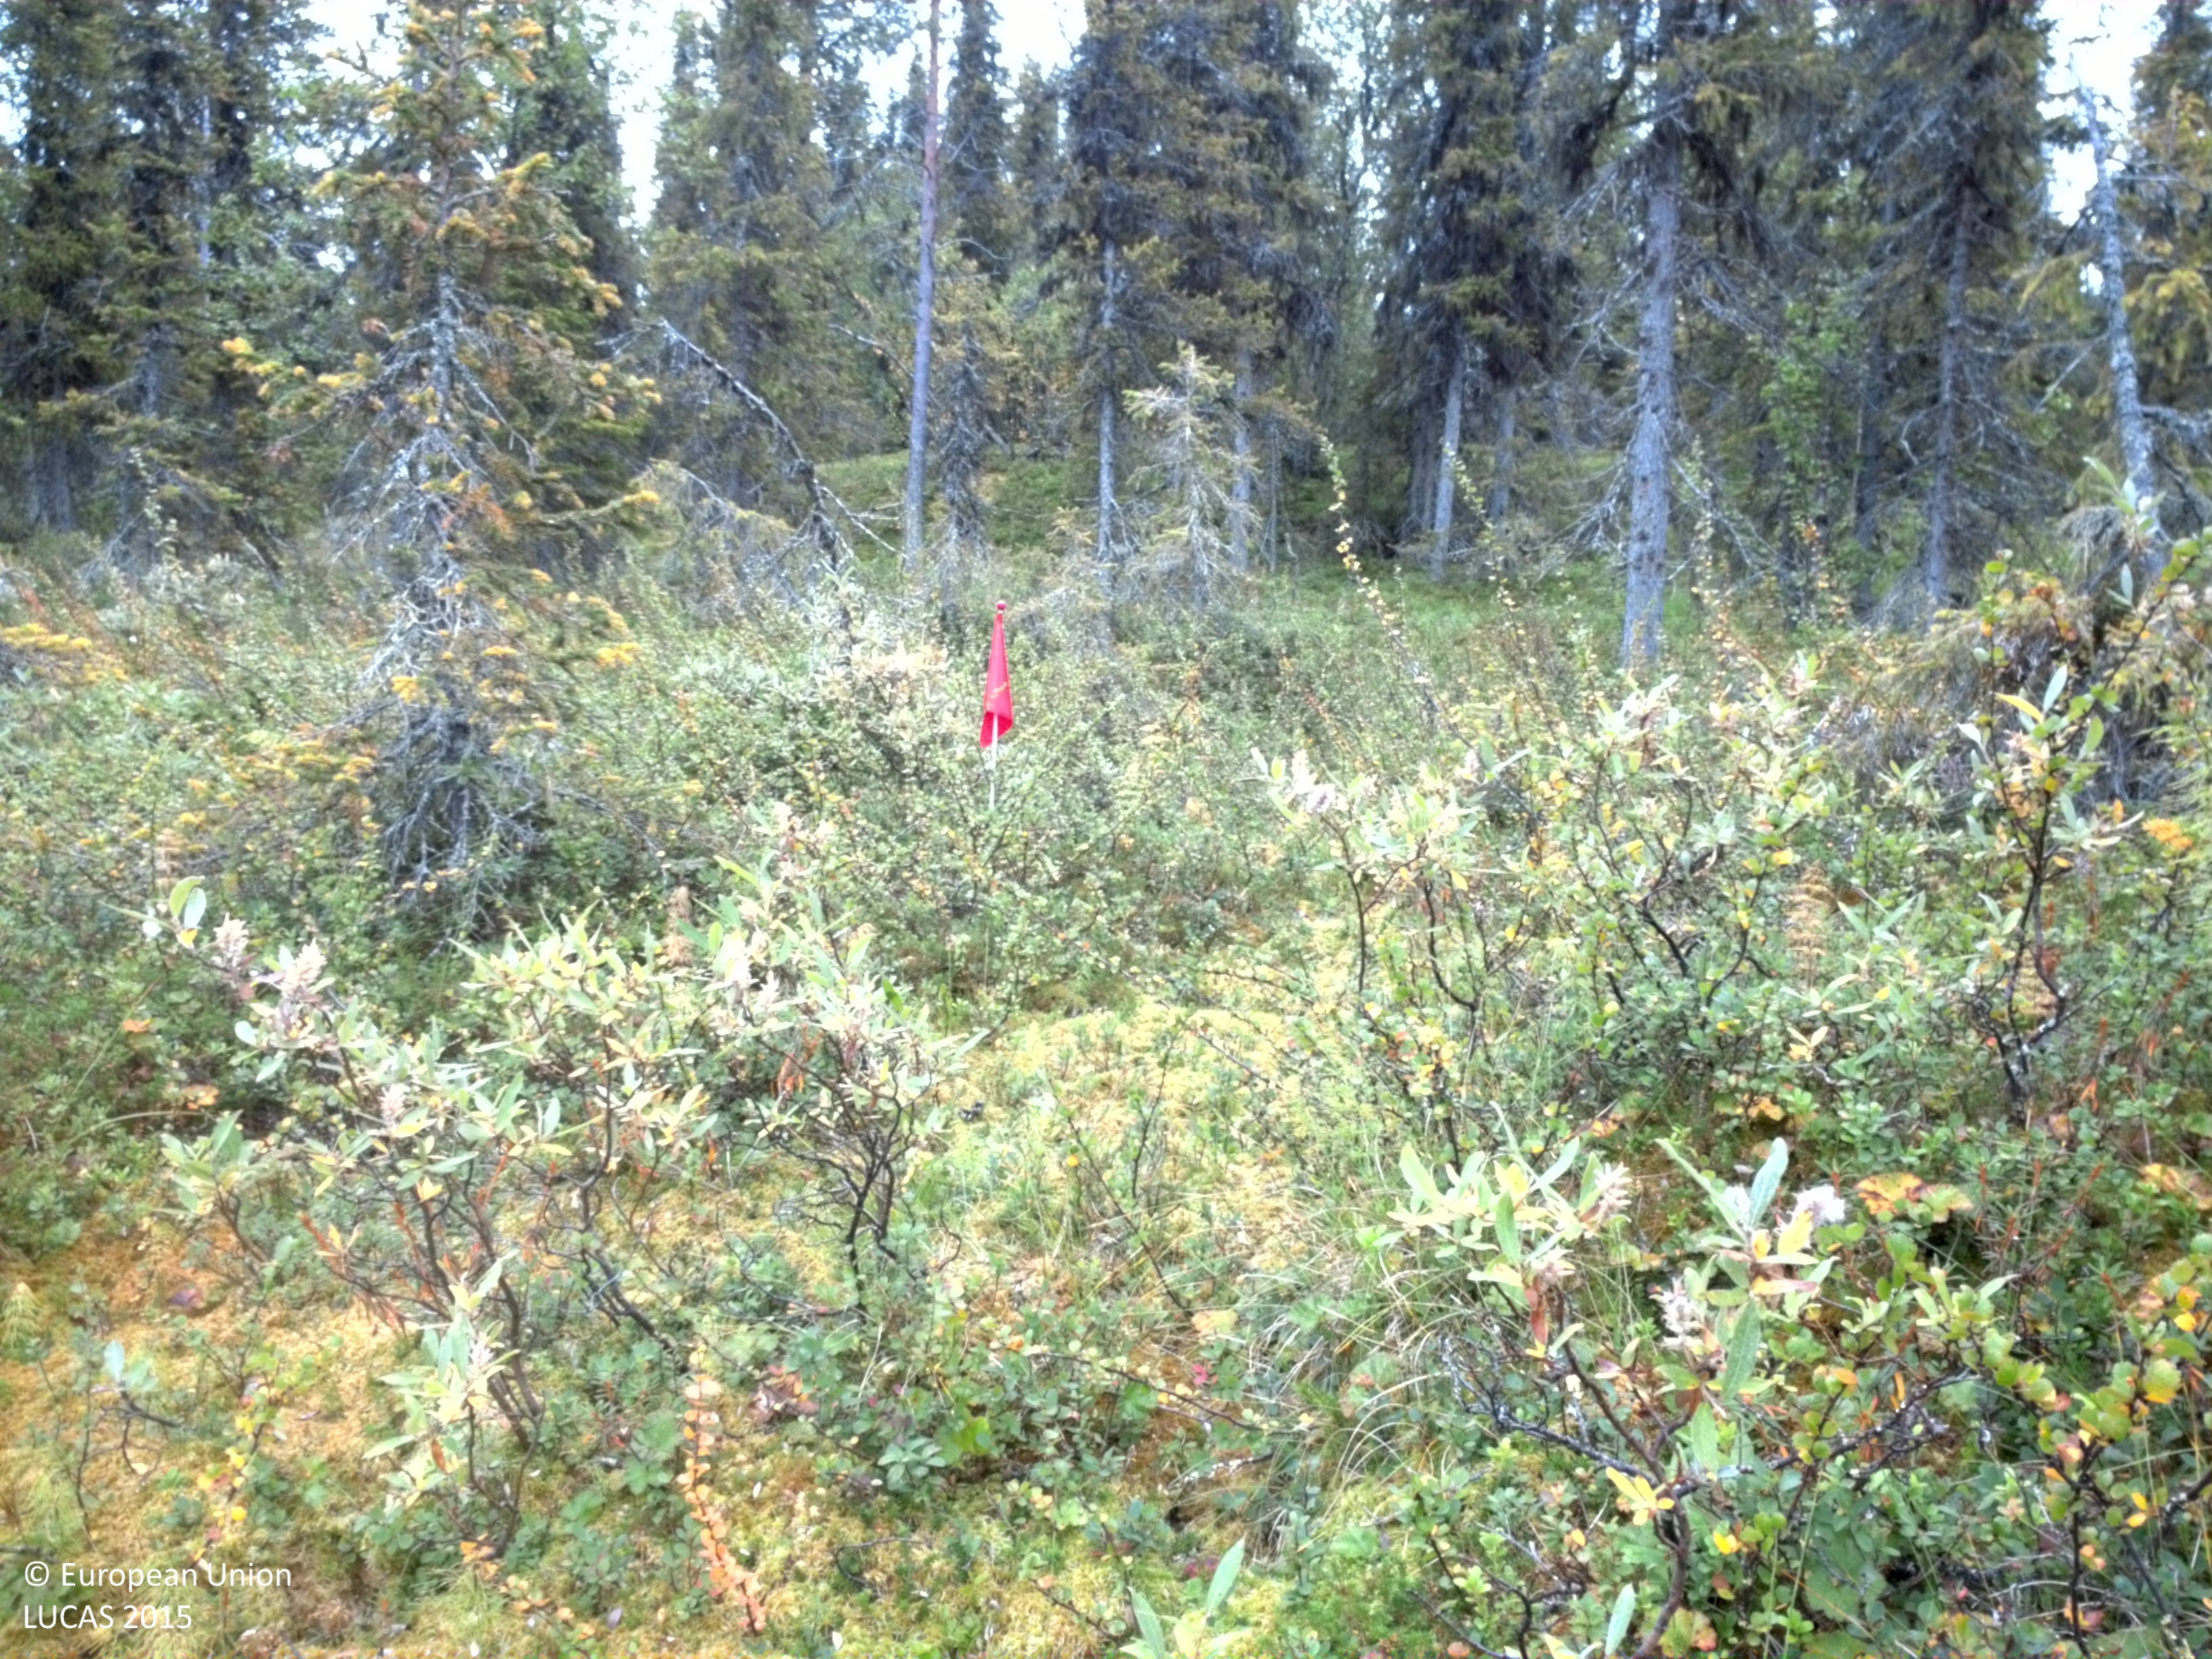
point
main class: Woodland
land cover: Spruce dominated coniferous woodland
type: boreal forest
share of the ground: 25 - 50 %
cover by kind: shrubs 65 %, coniferous forest trees 30 %, broadleaved forest trees 5 %
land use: Forestry
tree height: > 5 m
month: August
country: SE
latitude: 67.0630
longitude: 19.5812
